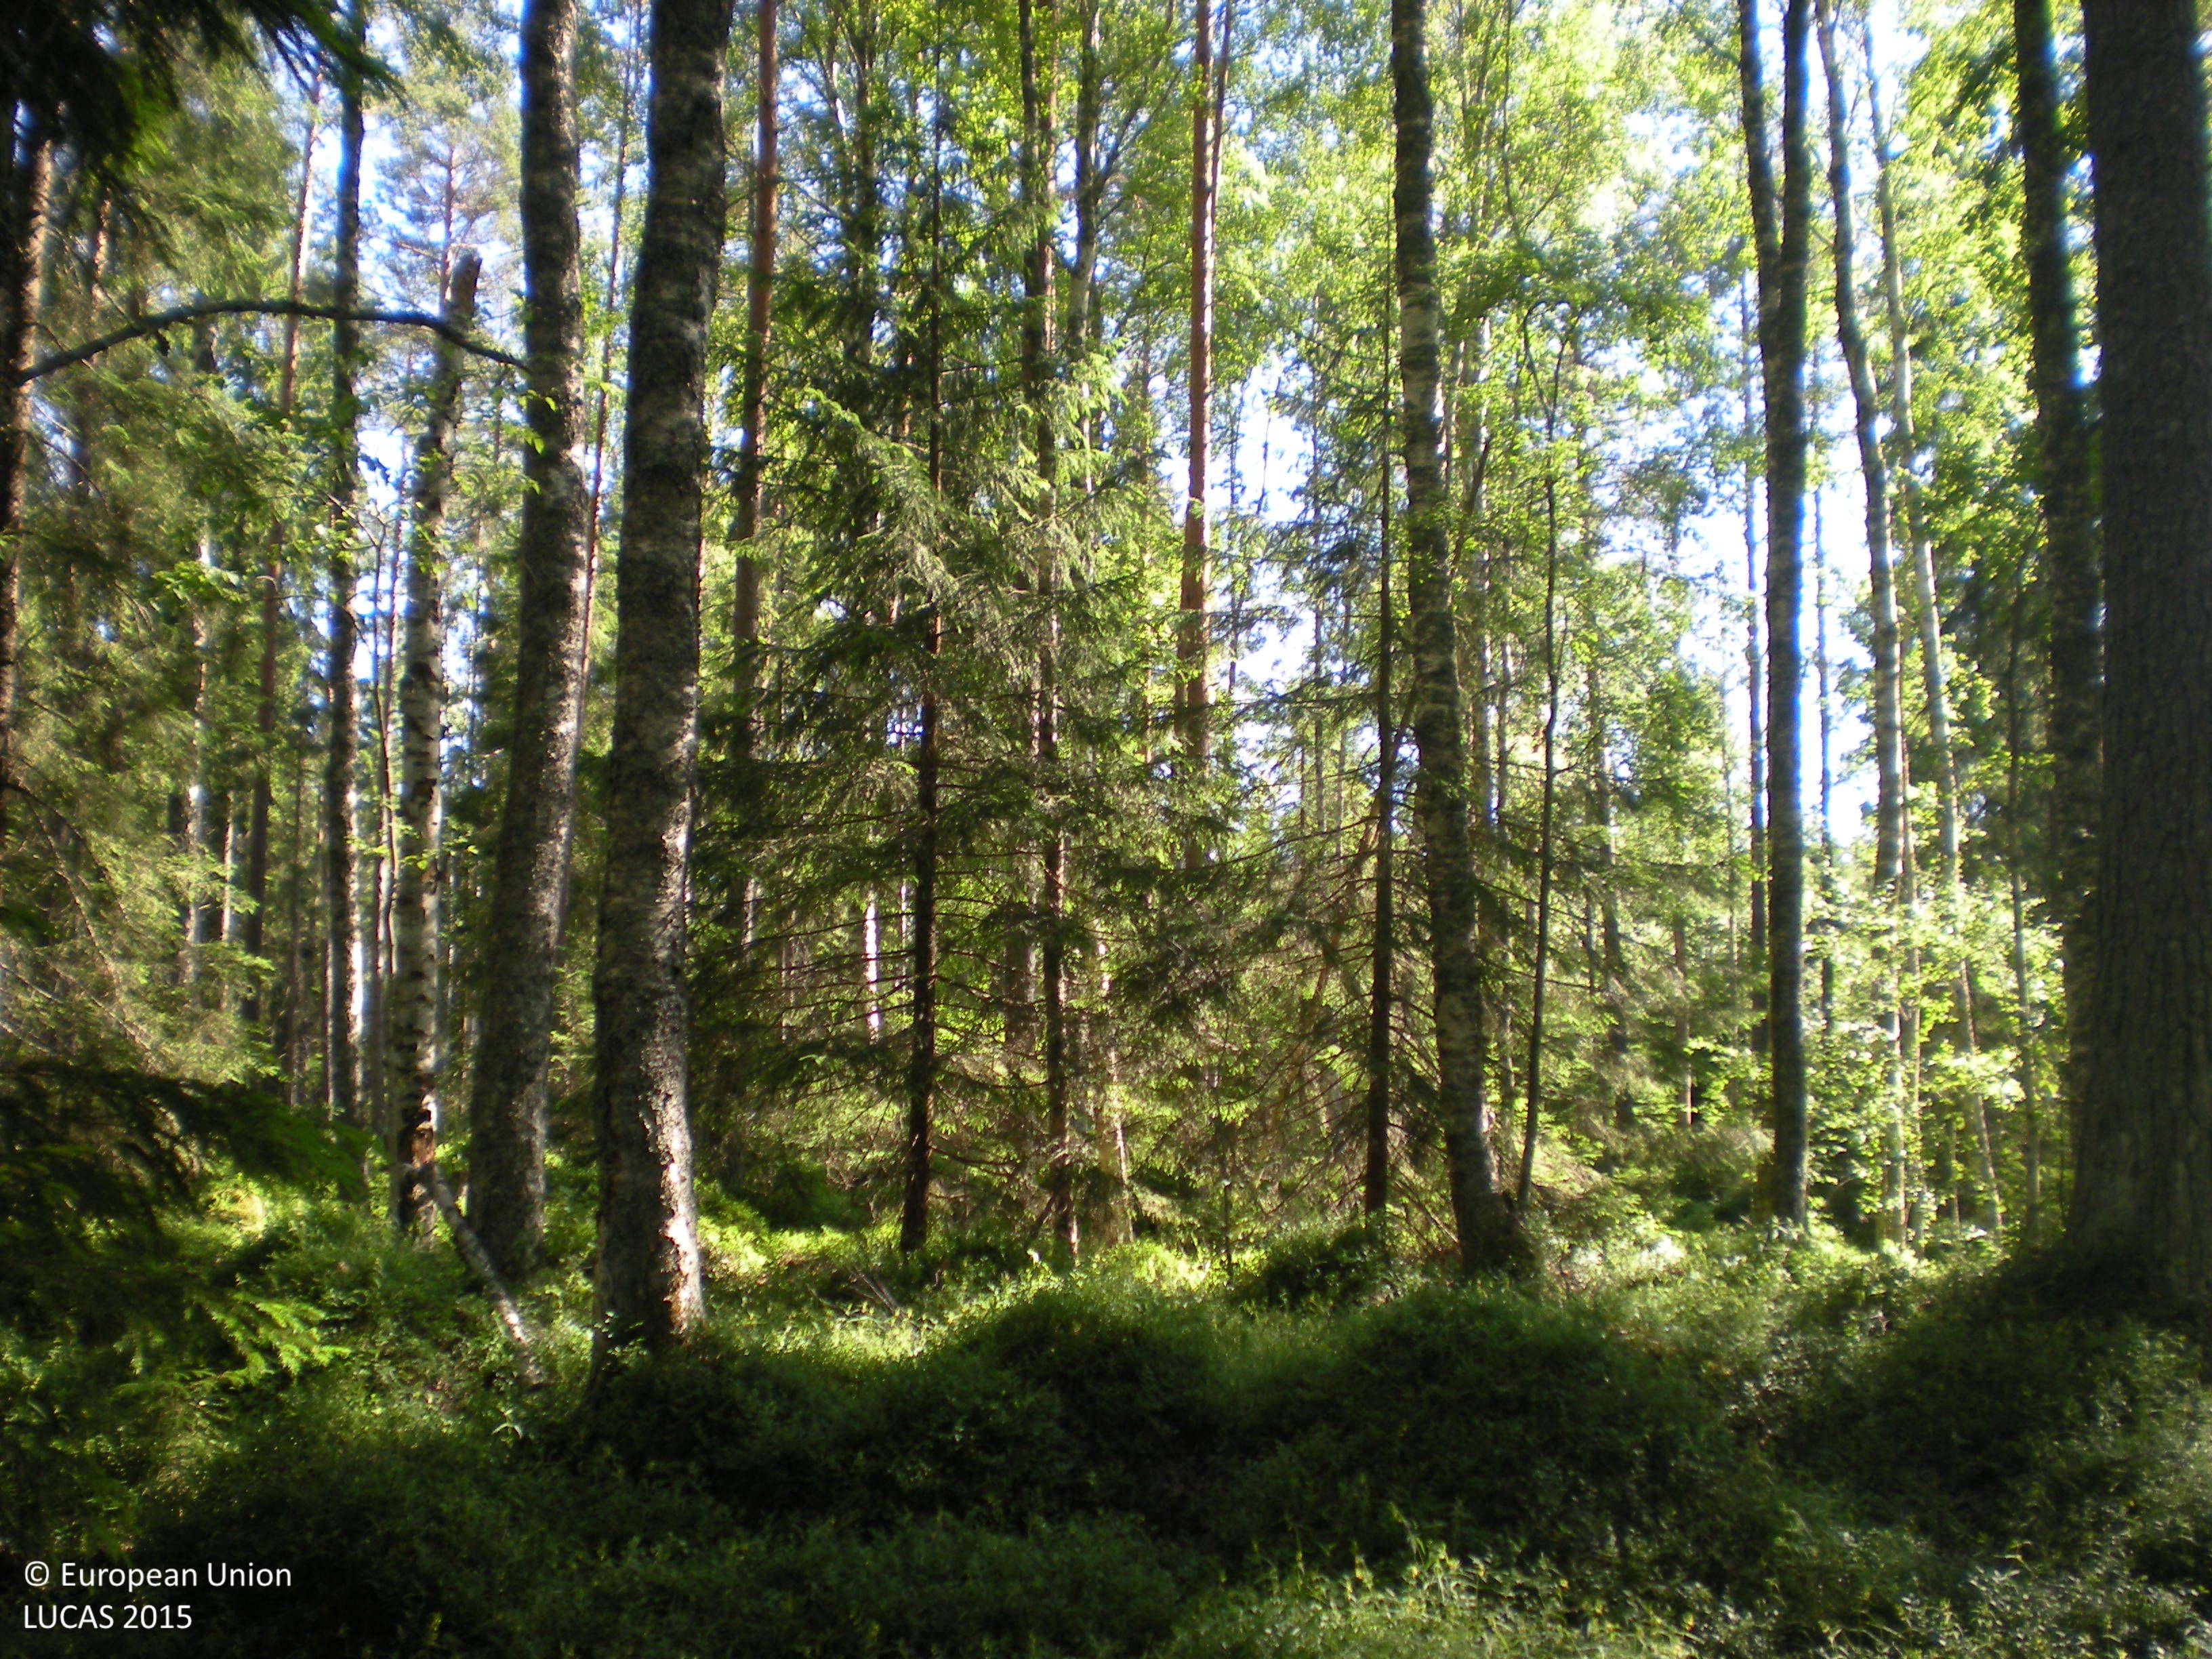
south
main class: Woodland
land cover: Pine dominated mixed woodland
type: boreal forest
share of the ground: 50 - 75 %
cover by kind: coniferous forest trees 60 %, broadleaved forest trees 20 %, shrubs 15 %, herbaceous plants 5 %
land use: Forestry
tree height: > 5 m
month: July
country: SE
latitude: 60.5274
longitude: 17.7720
